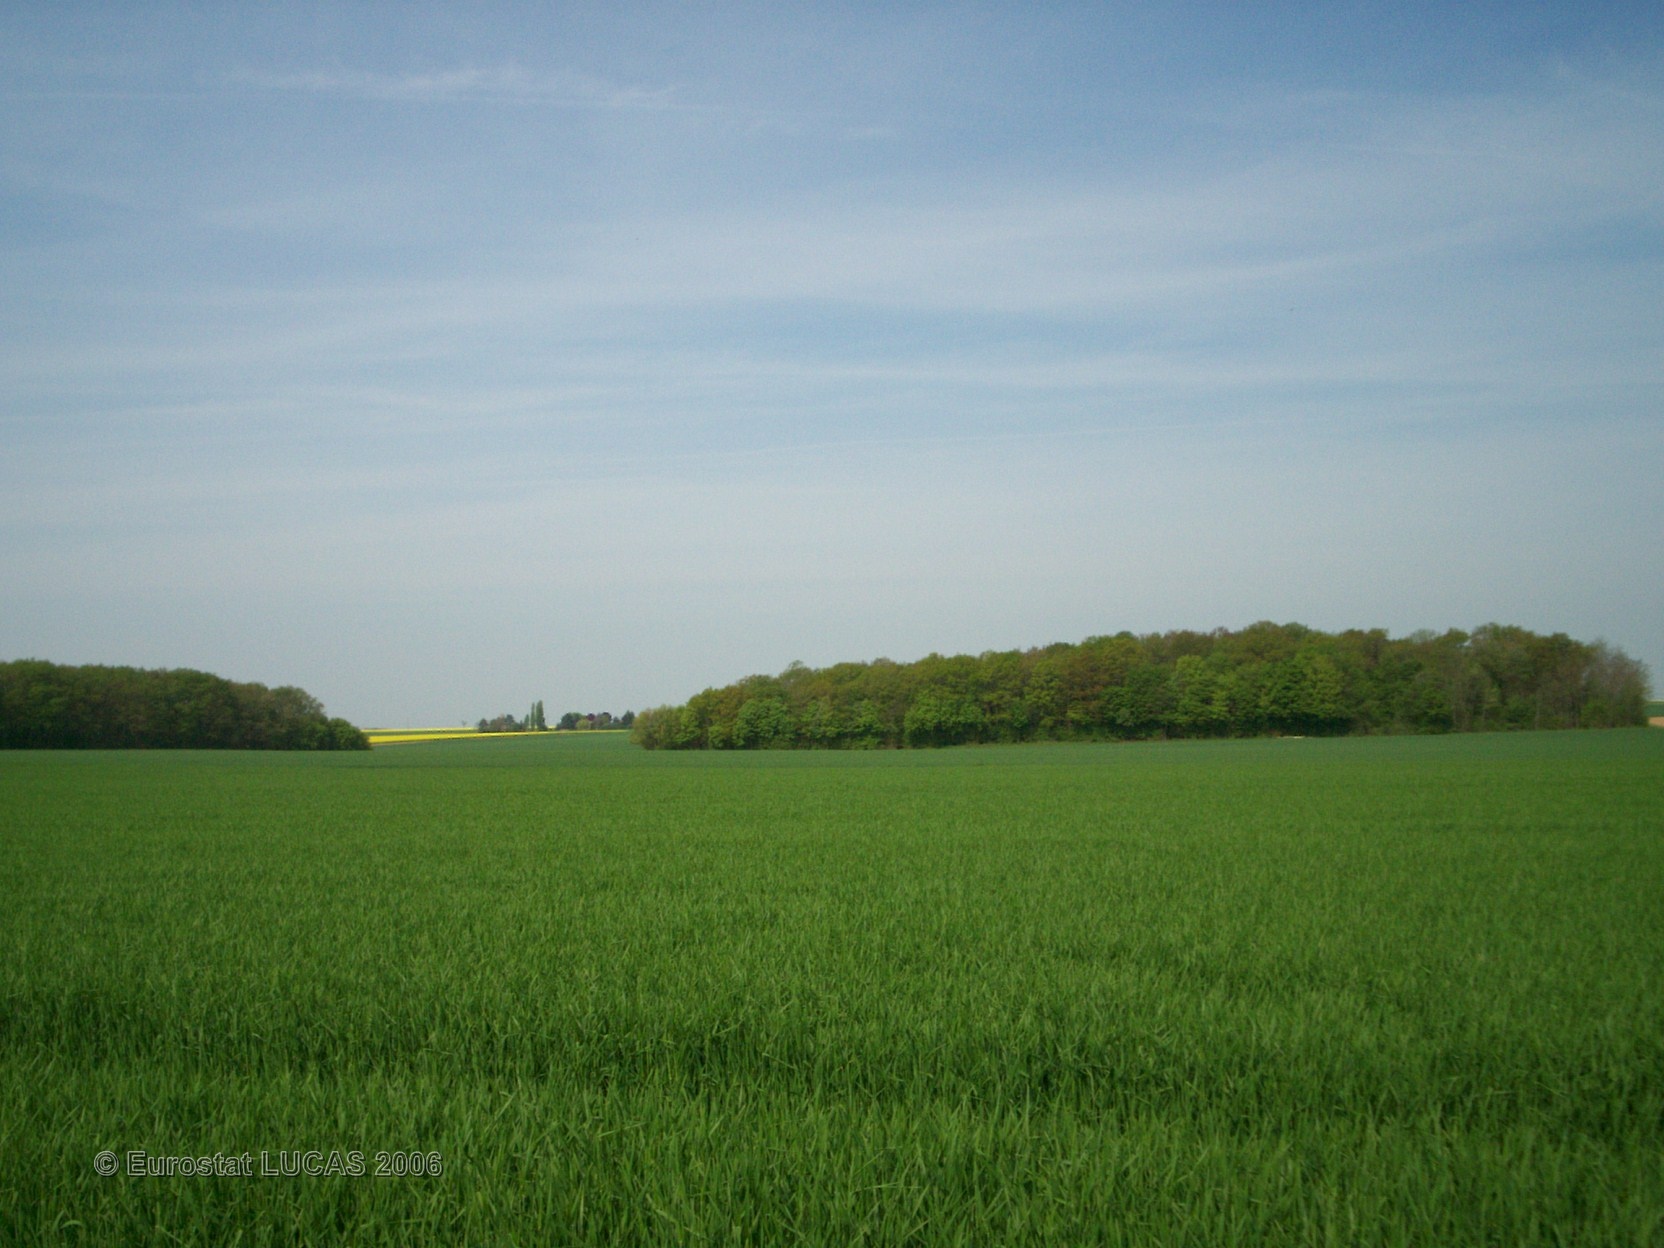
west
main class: Cropland
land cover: Barley
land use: Agriculture (excluding fallow land and kitchen gardens)
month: May
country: FR
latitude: 48.0698
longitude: 2.9467
